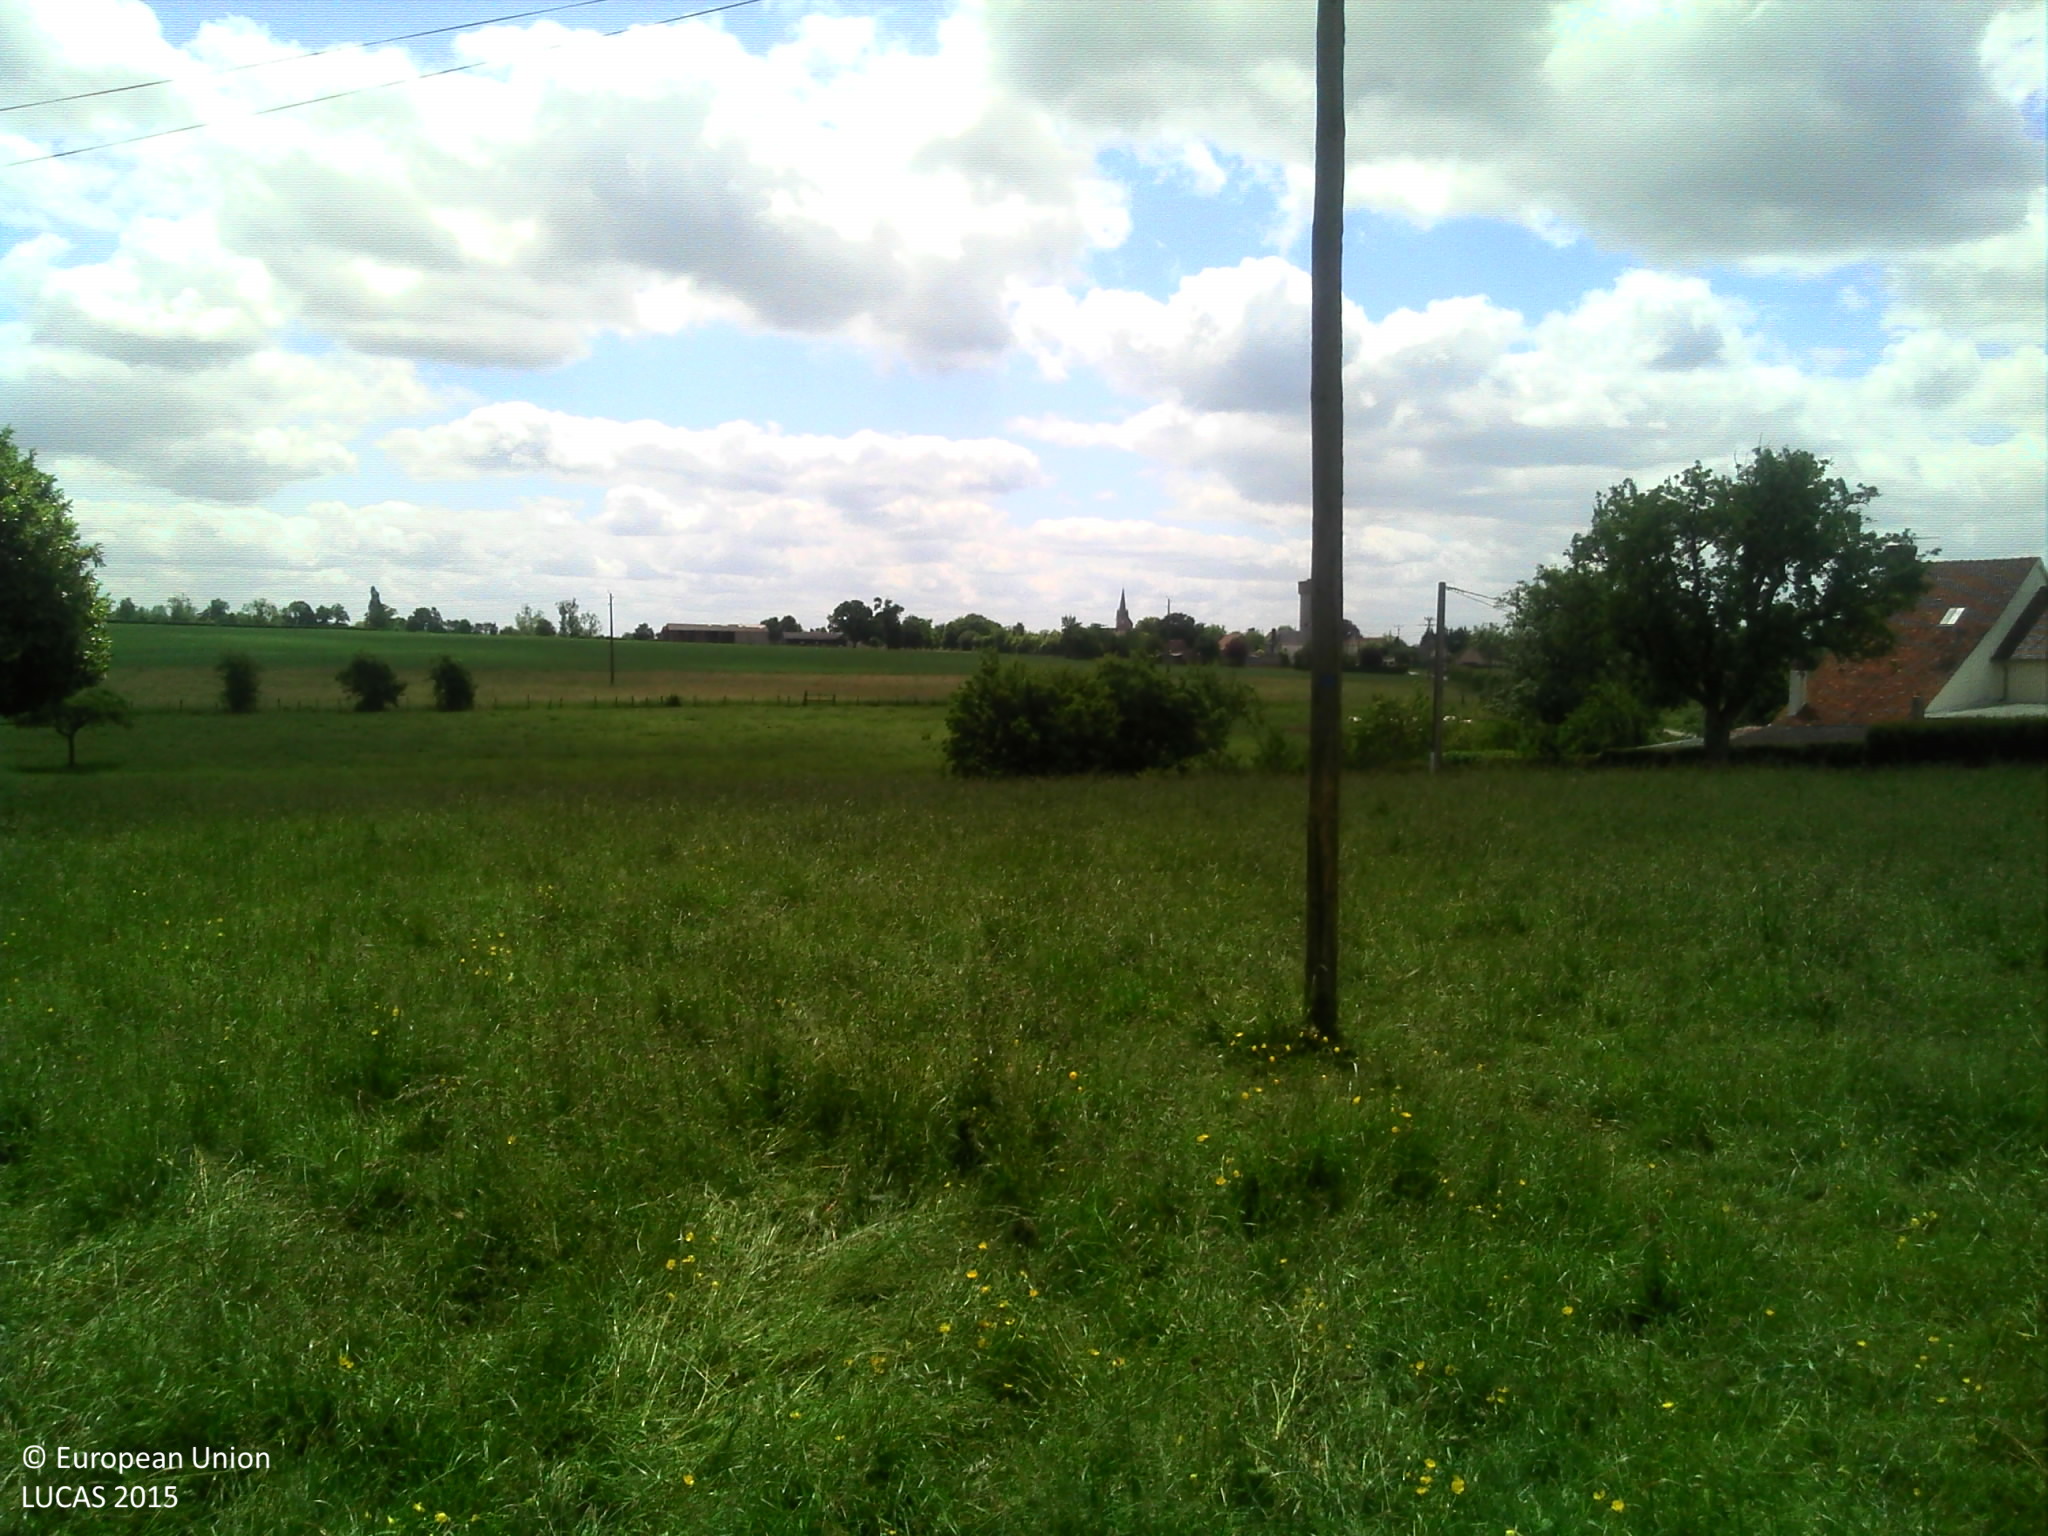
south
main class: Grassland
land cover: Grassland without tree/shrub cover
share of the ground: > 75 %
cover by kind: herbaceous plants 95 %
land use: Agriculture (excluding fallow land and kitchen gardens)
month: June
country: FR
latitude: 48.8763
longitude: 0.0299
